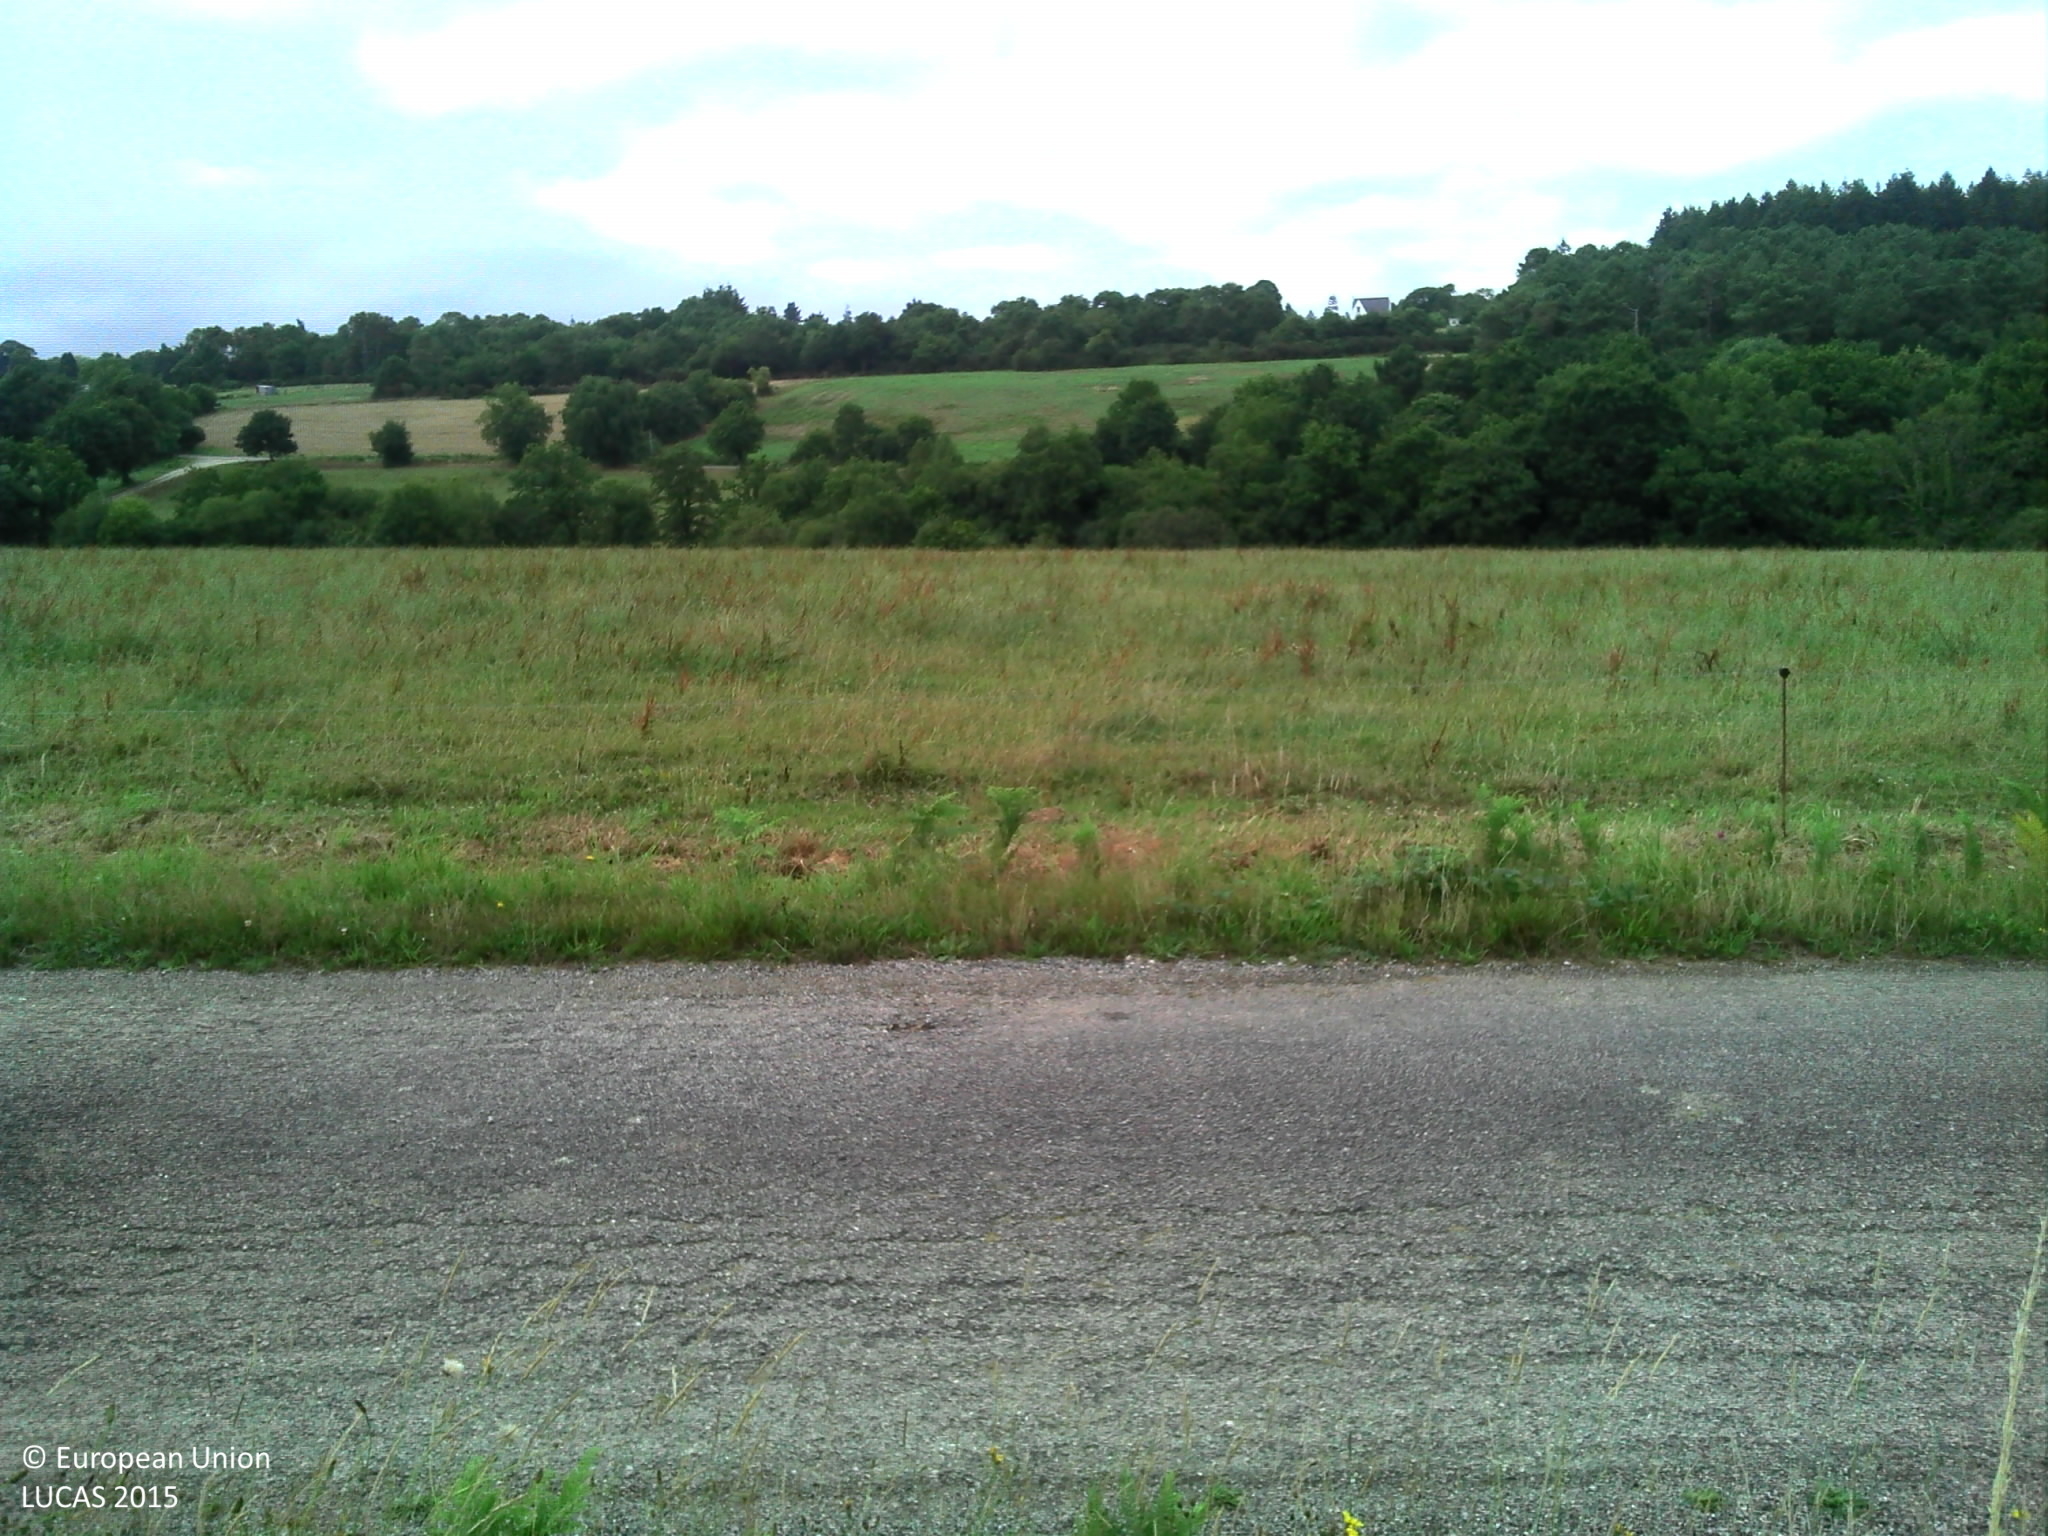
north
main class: Cropland
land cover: Lucerne
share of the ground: > 75 %
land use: Agriculture (excluding fallow land and kitchen gardens)
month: July
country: FR
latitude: 47.8134
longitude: -3.0075
